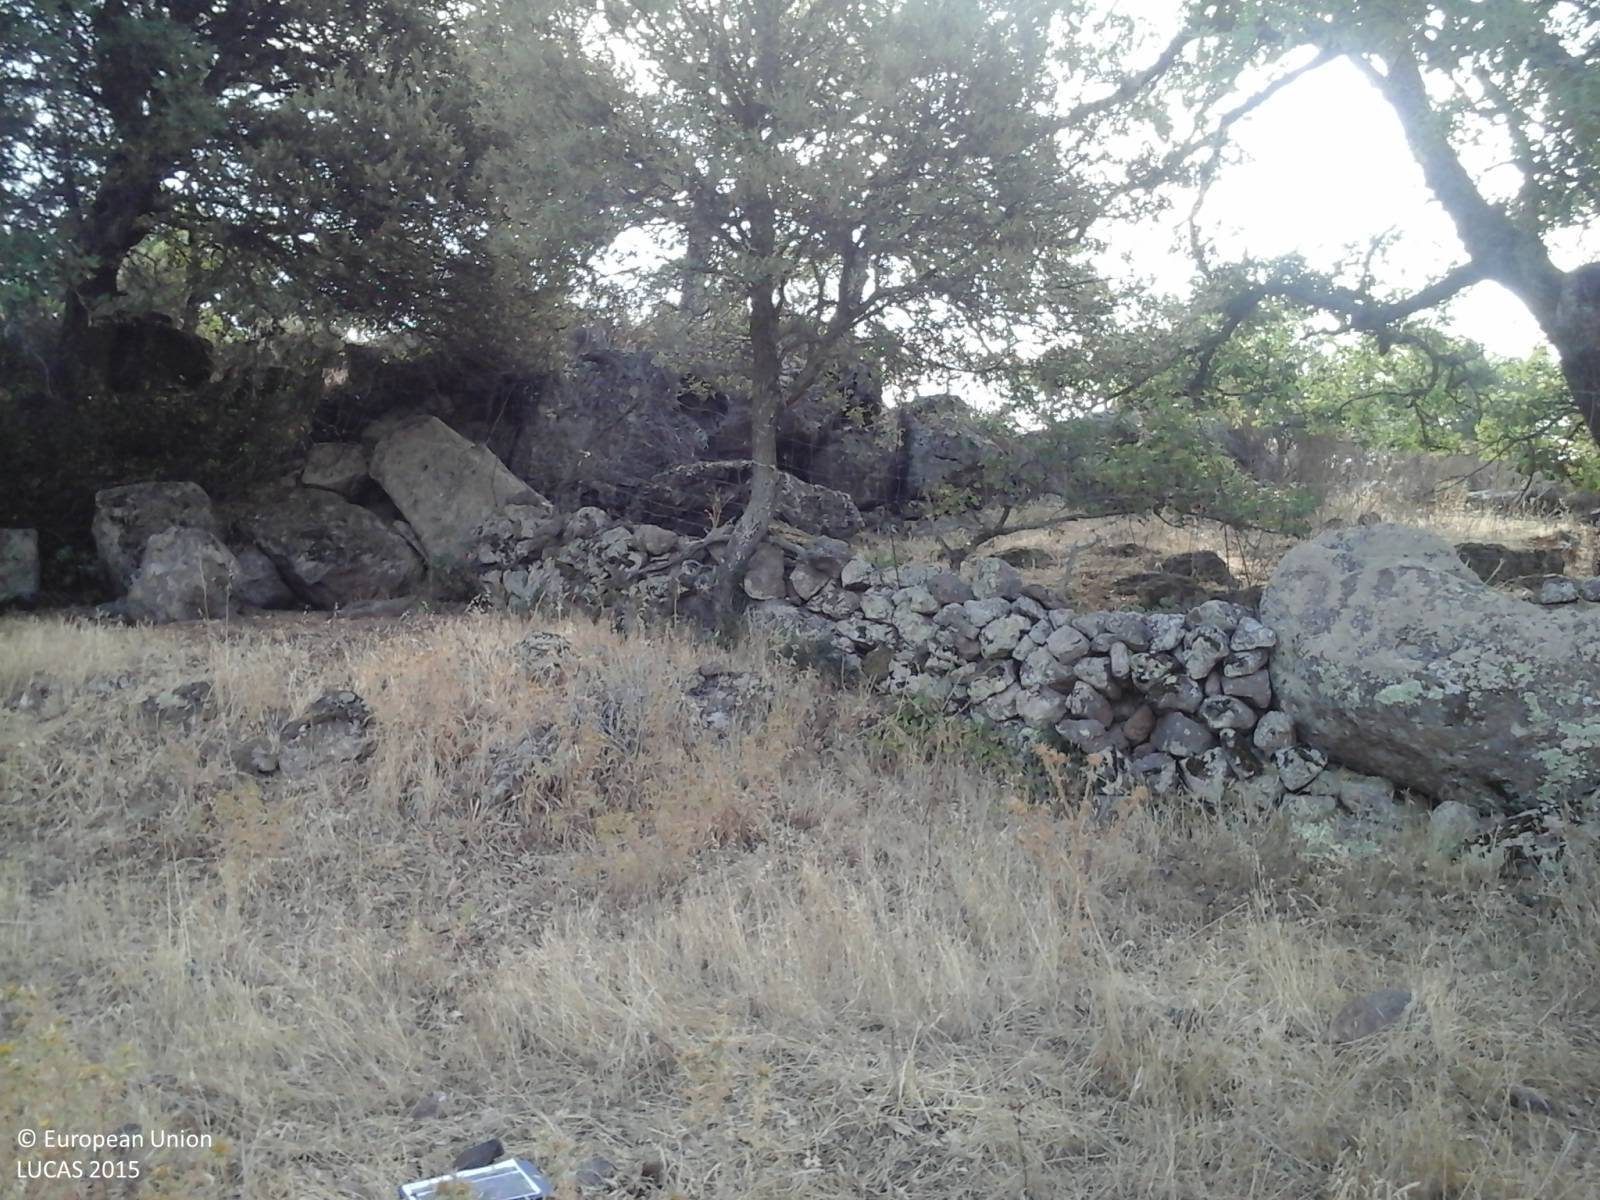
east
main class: Grassland
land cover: Grassland without tree/shrub cover
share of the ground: 50 - 75 %
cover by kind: herbaceous plants 100 %
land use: Agriculture (excluding fallow land and kitchen gardens)
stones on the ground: < 10 %
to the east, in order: Grassland without tree/shrub cover; Shrubland with sparse tree cover; Dry stone walls; Fences; Shrubland with sparse tree cover; Dry stone walls; Fences; Shrubland with sparse tree cover; Grassland without tree/shrub cover; Shrubland without tree cover; Grassland without tree/shrub cover; Dry stone walls; Fences; Grassland without tree/shrub cover
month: July
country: IT
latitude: 40.7315
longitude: 8.8806
